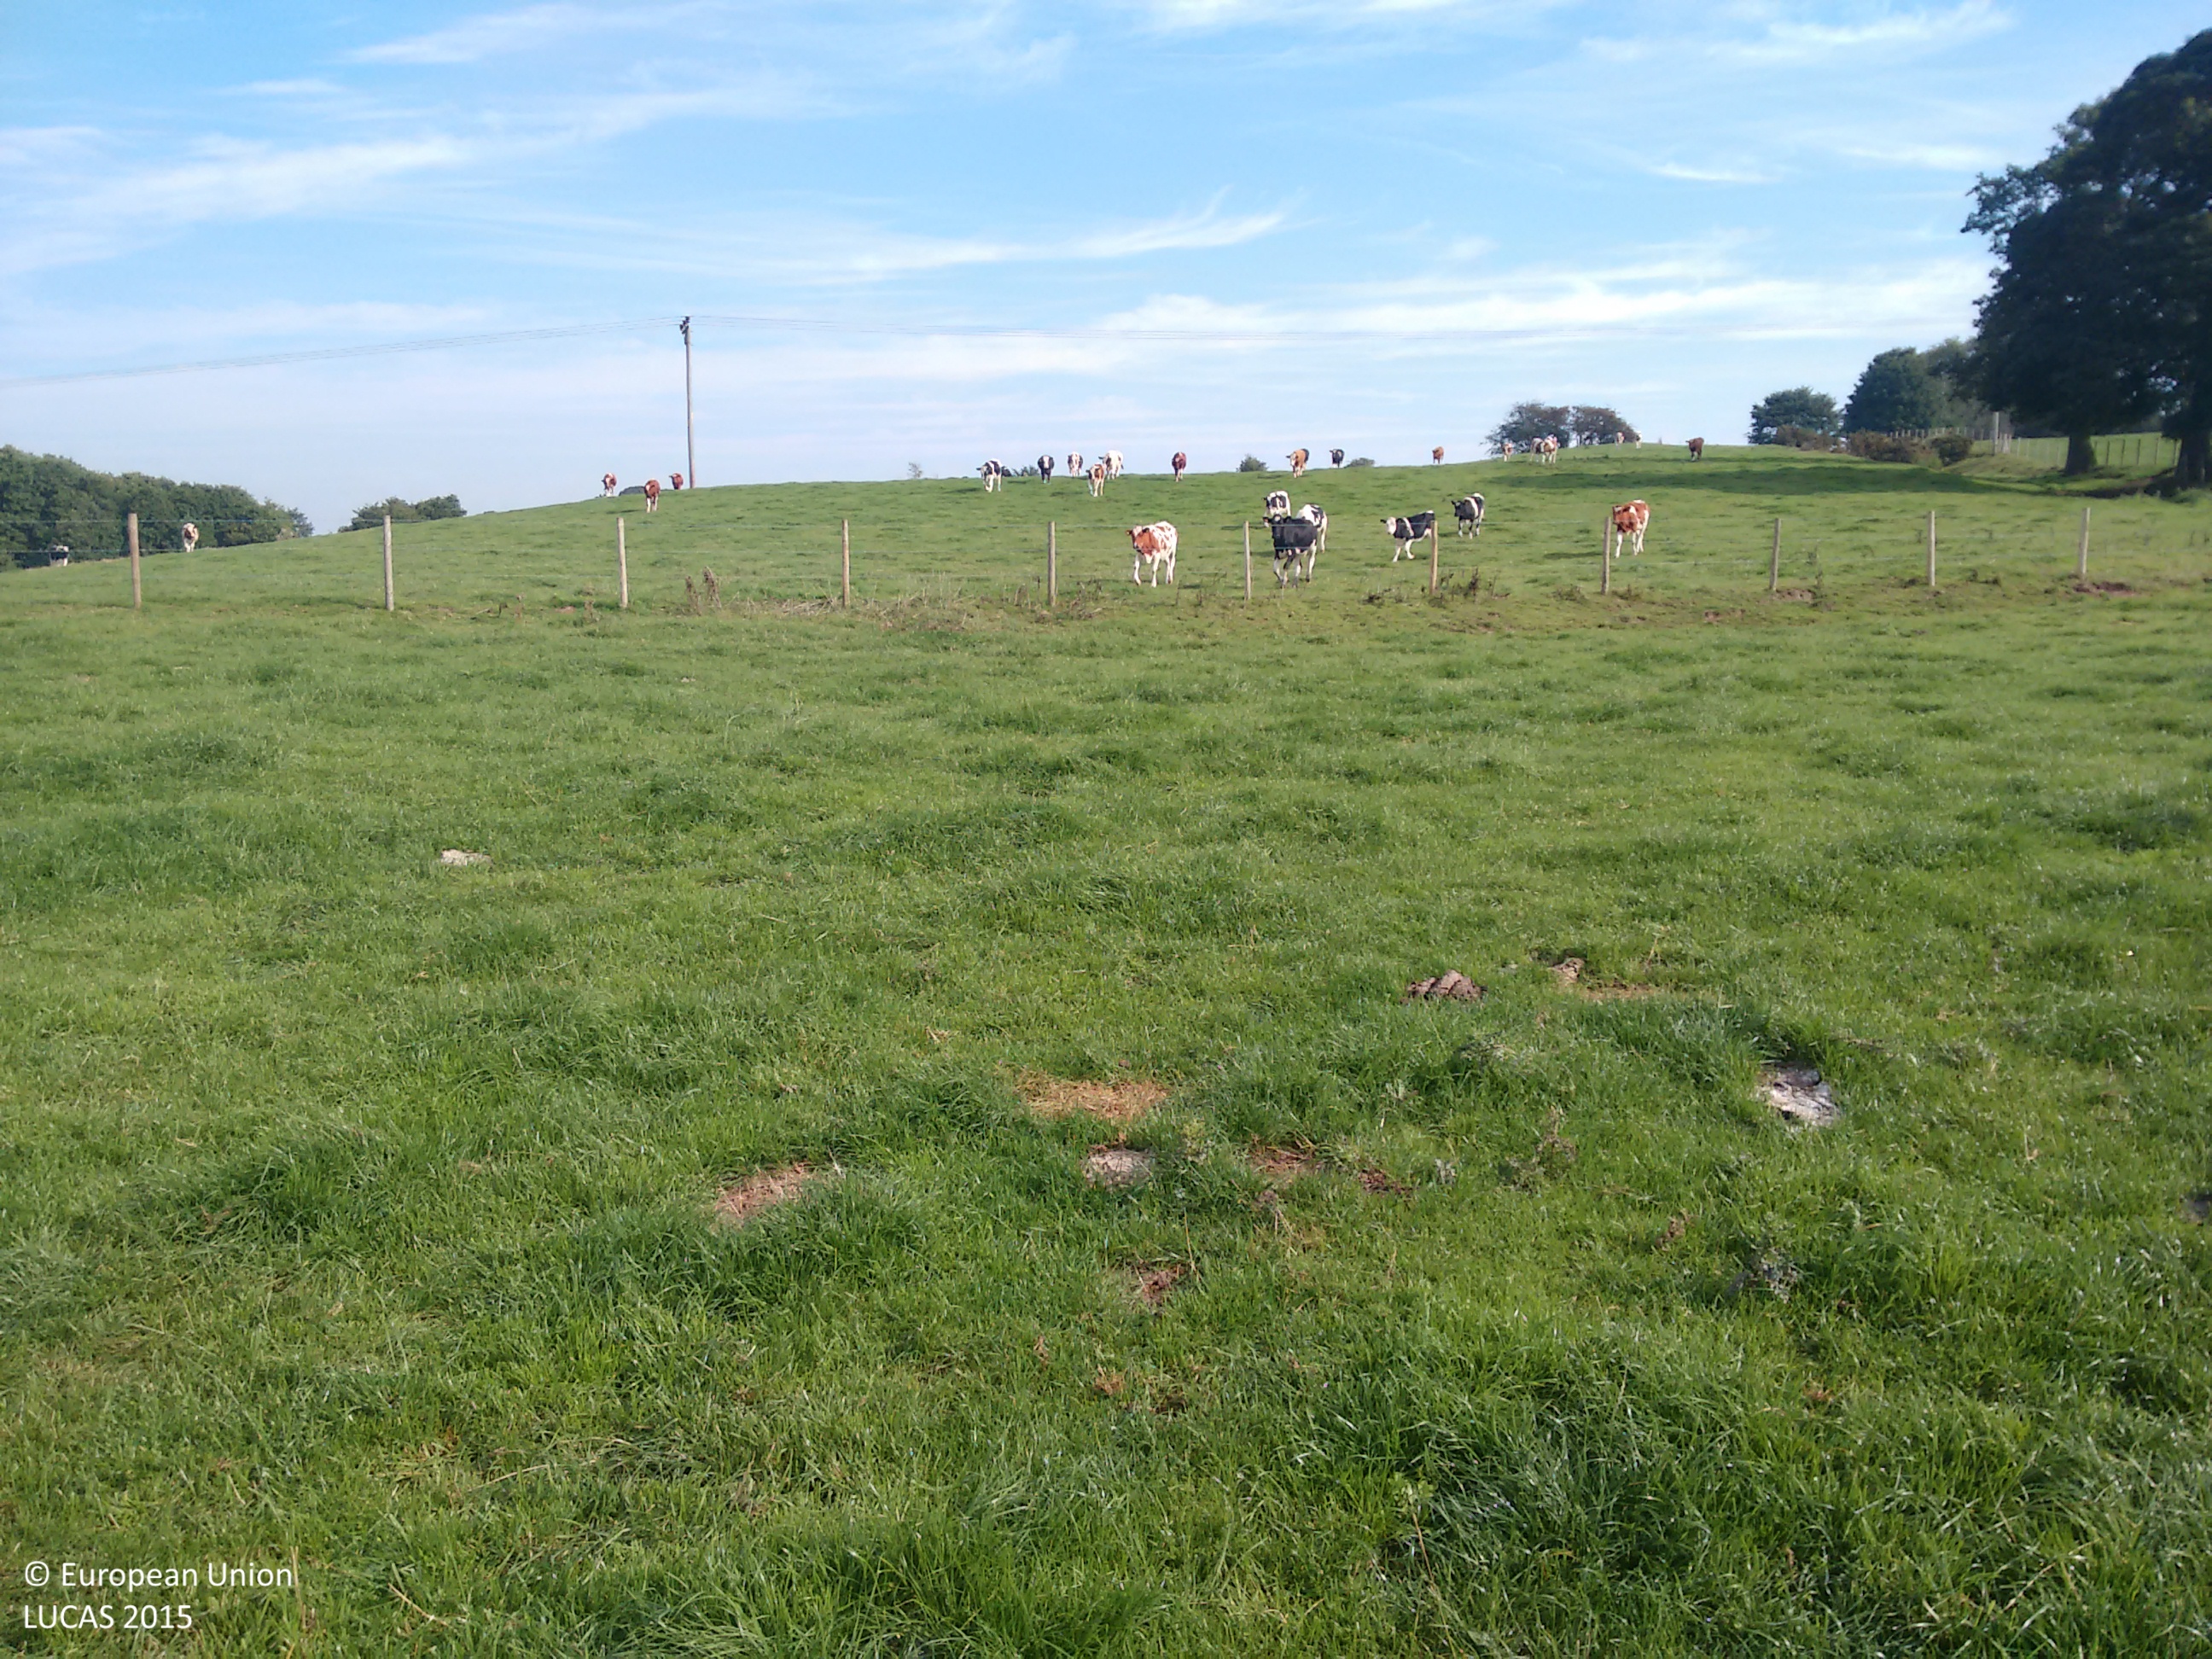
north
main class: Grassland
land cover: Grassland without tree/shrub cover
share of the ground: > 75 %
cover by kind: herbaceous plants 100 %
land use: Agriculture (excluding fallow land and kitchen gardens)
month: September
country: GB
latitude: 52.9863
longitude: -2.6859
